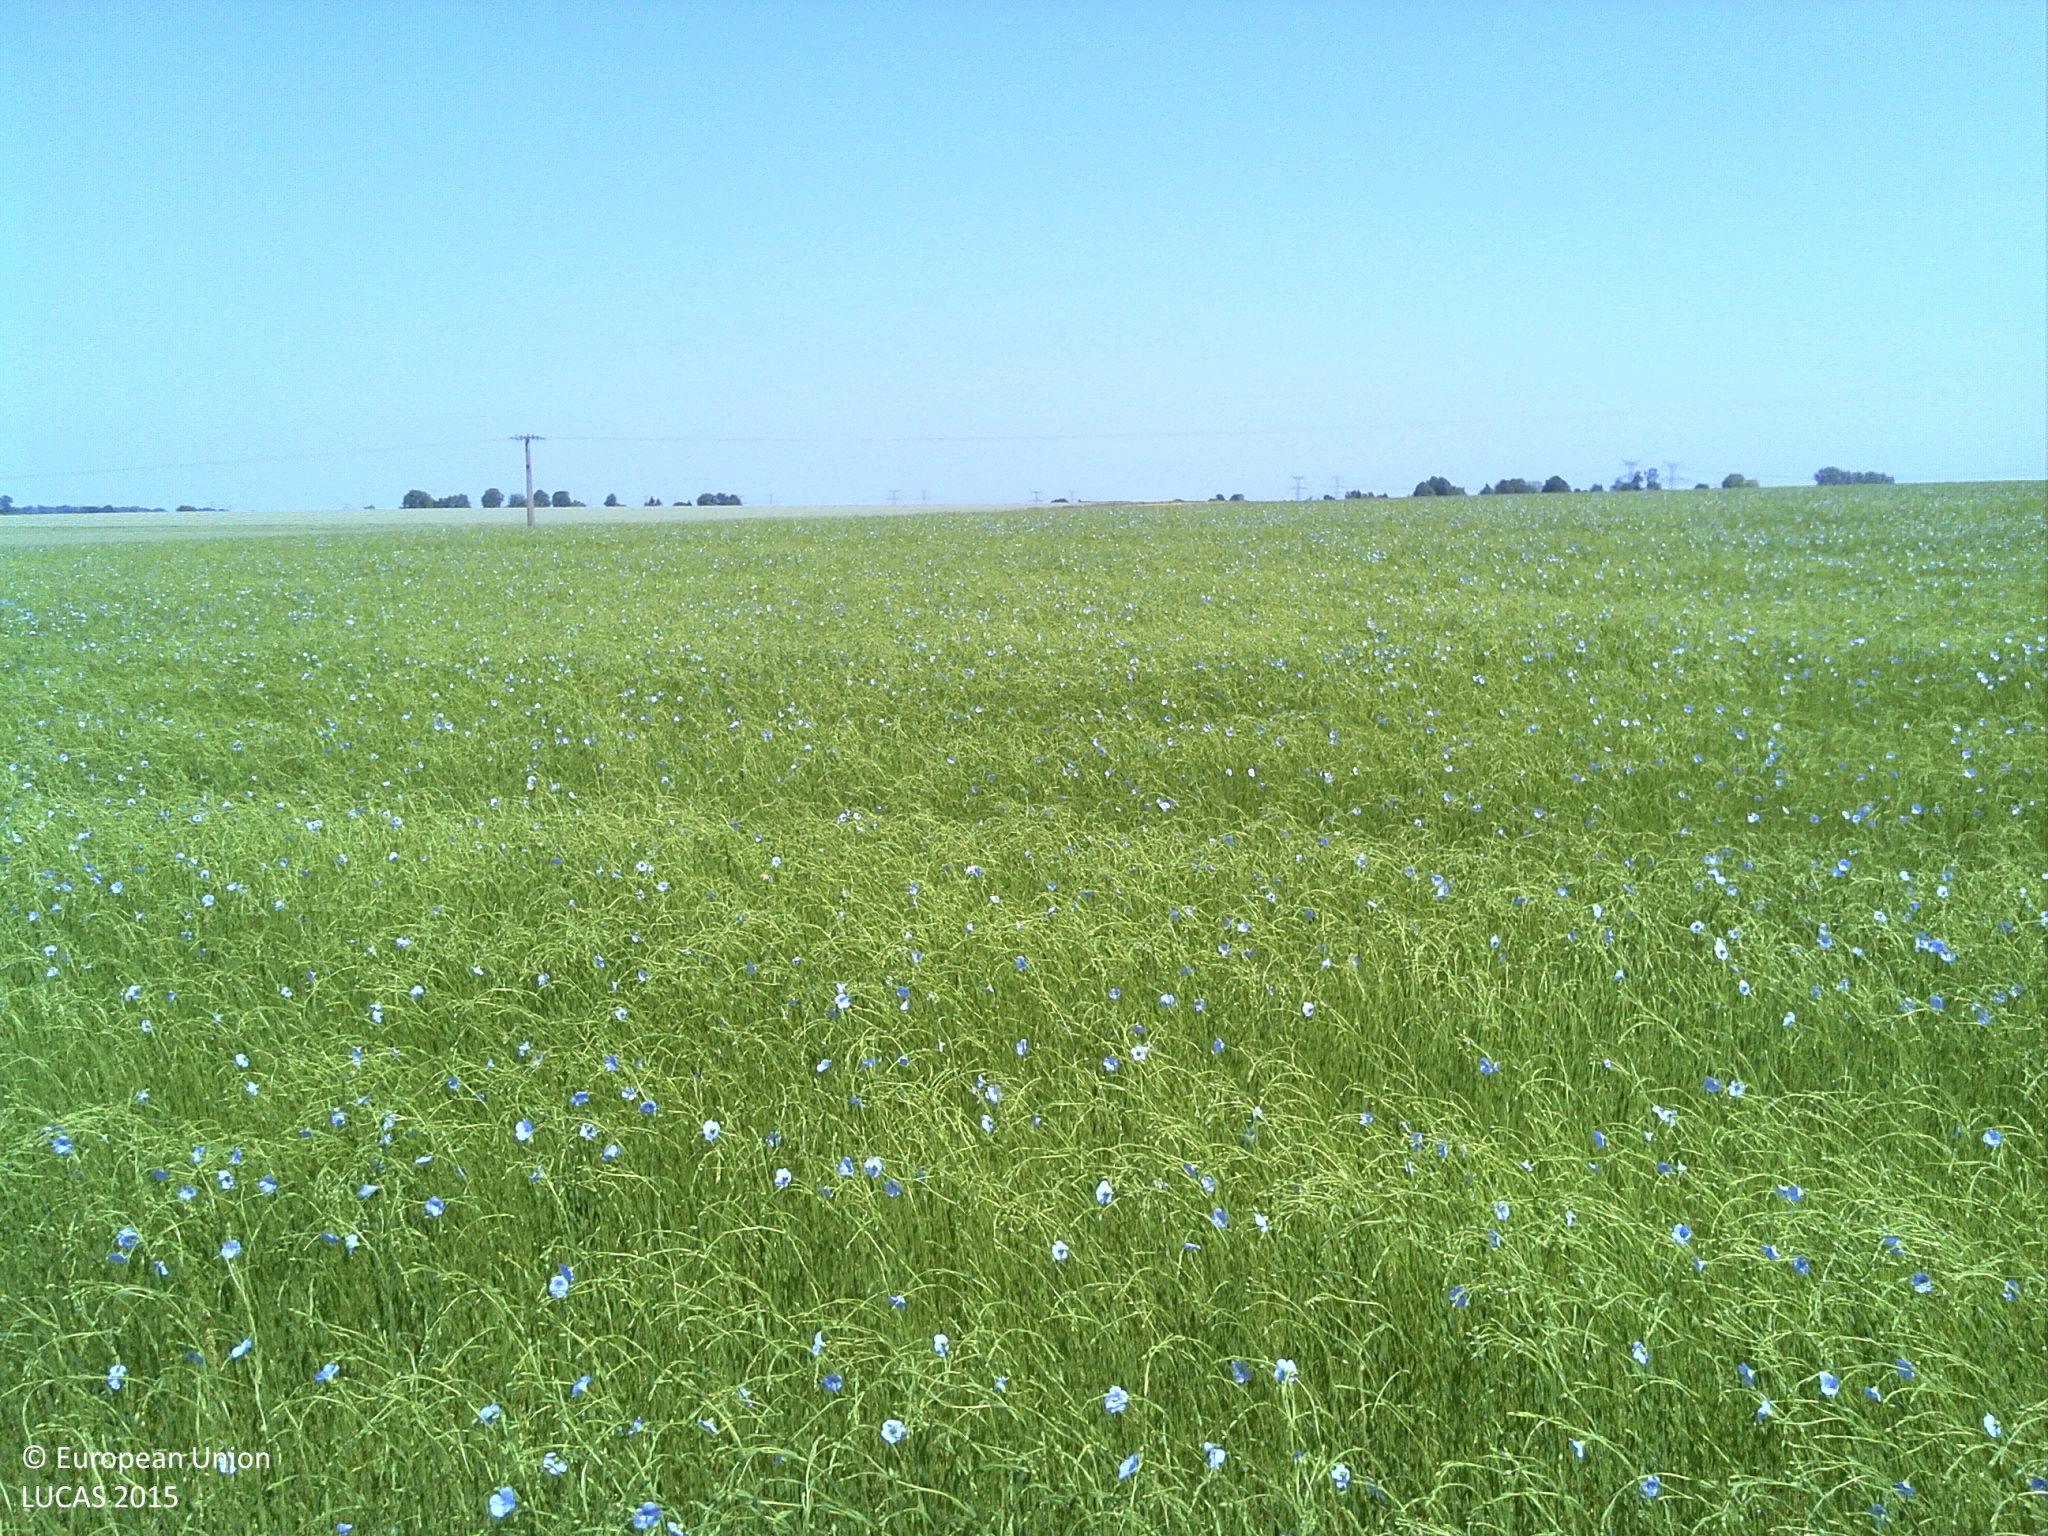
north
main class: Cropland
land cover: Other fibre and oleaginous crops
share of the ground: > 75 %
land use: Agriculture (excluding fallow land and kitchen gardens)
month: June
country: FR
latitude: 49.5876
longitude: 1.1675
